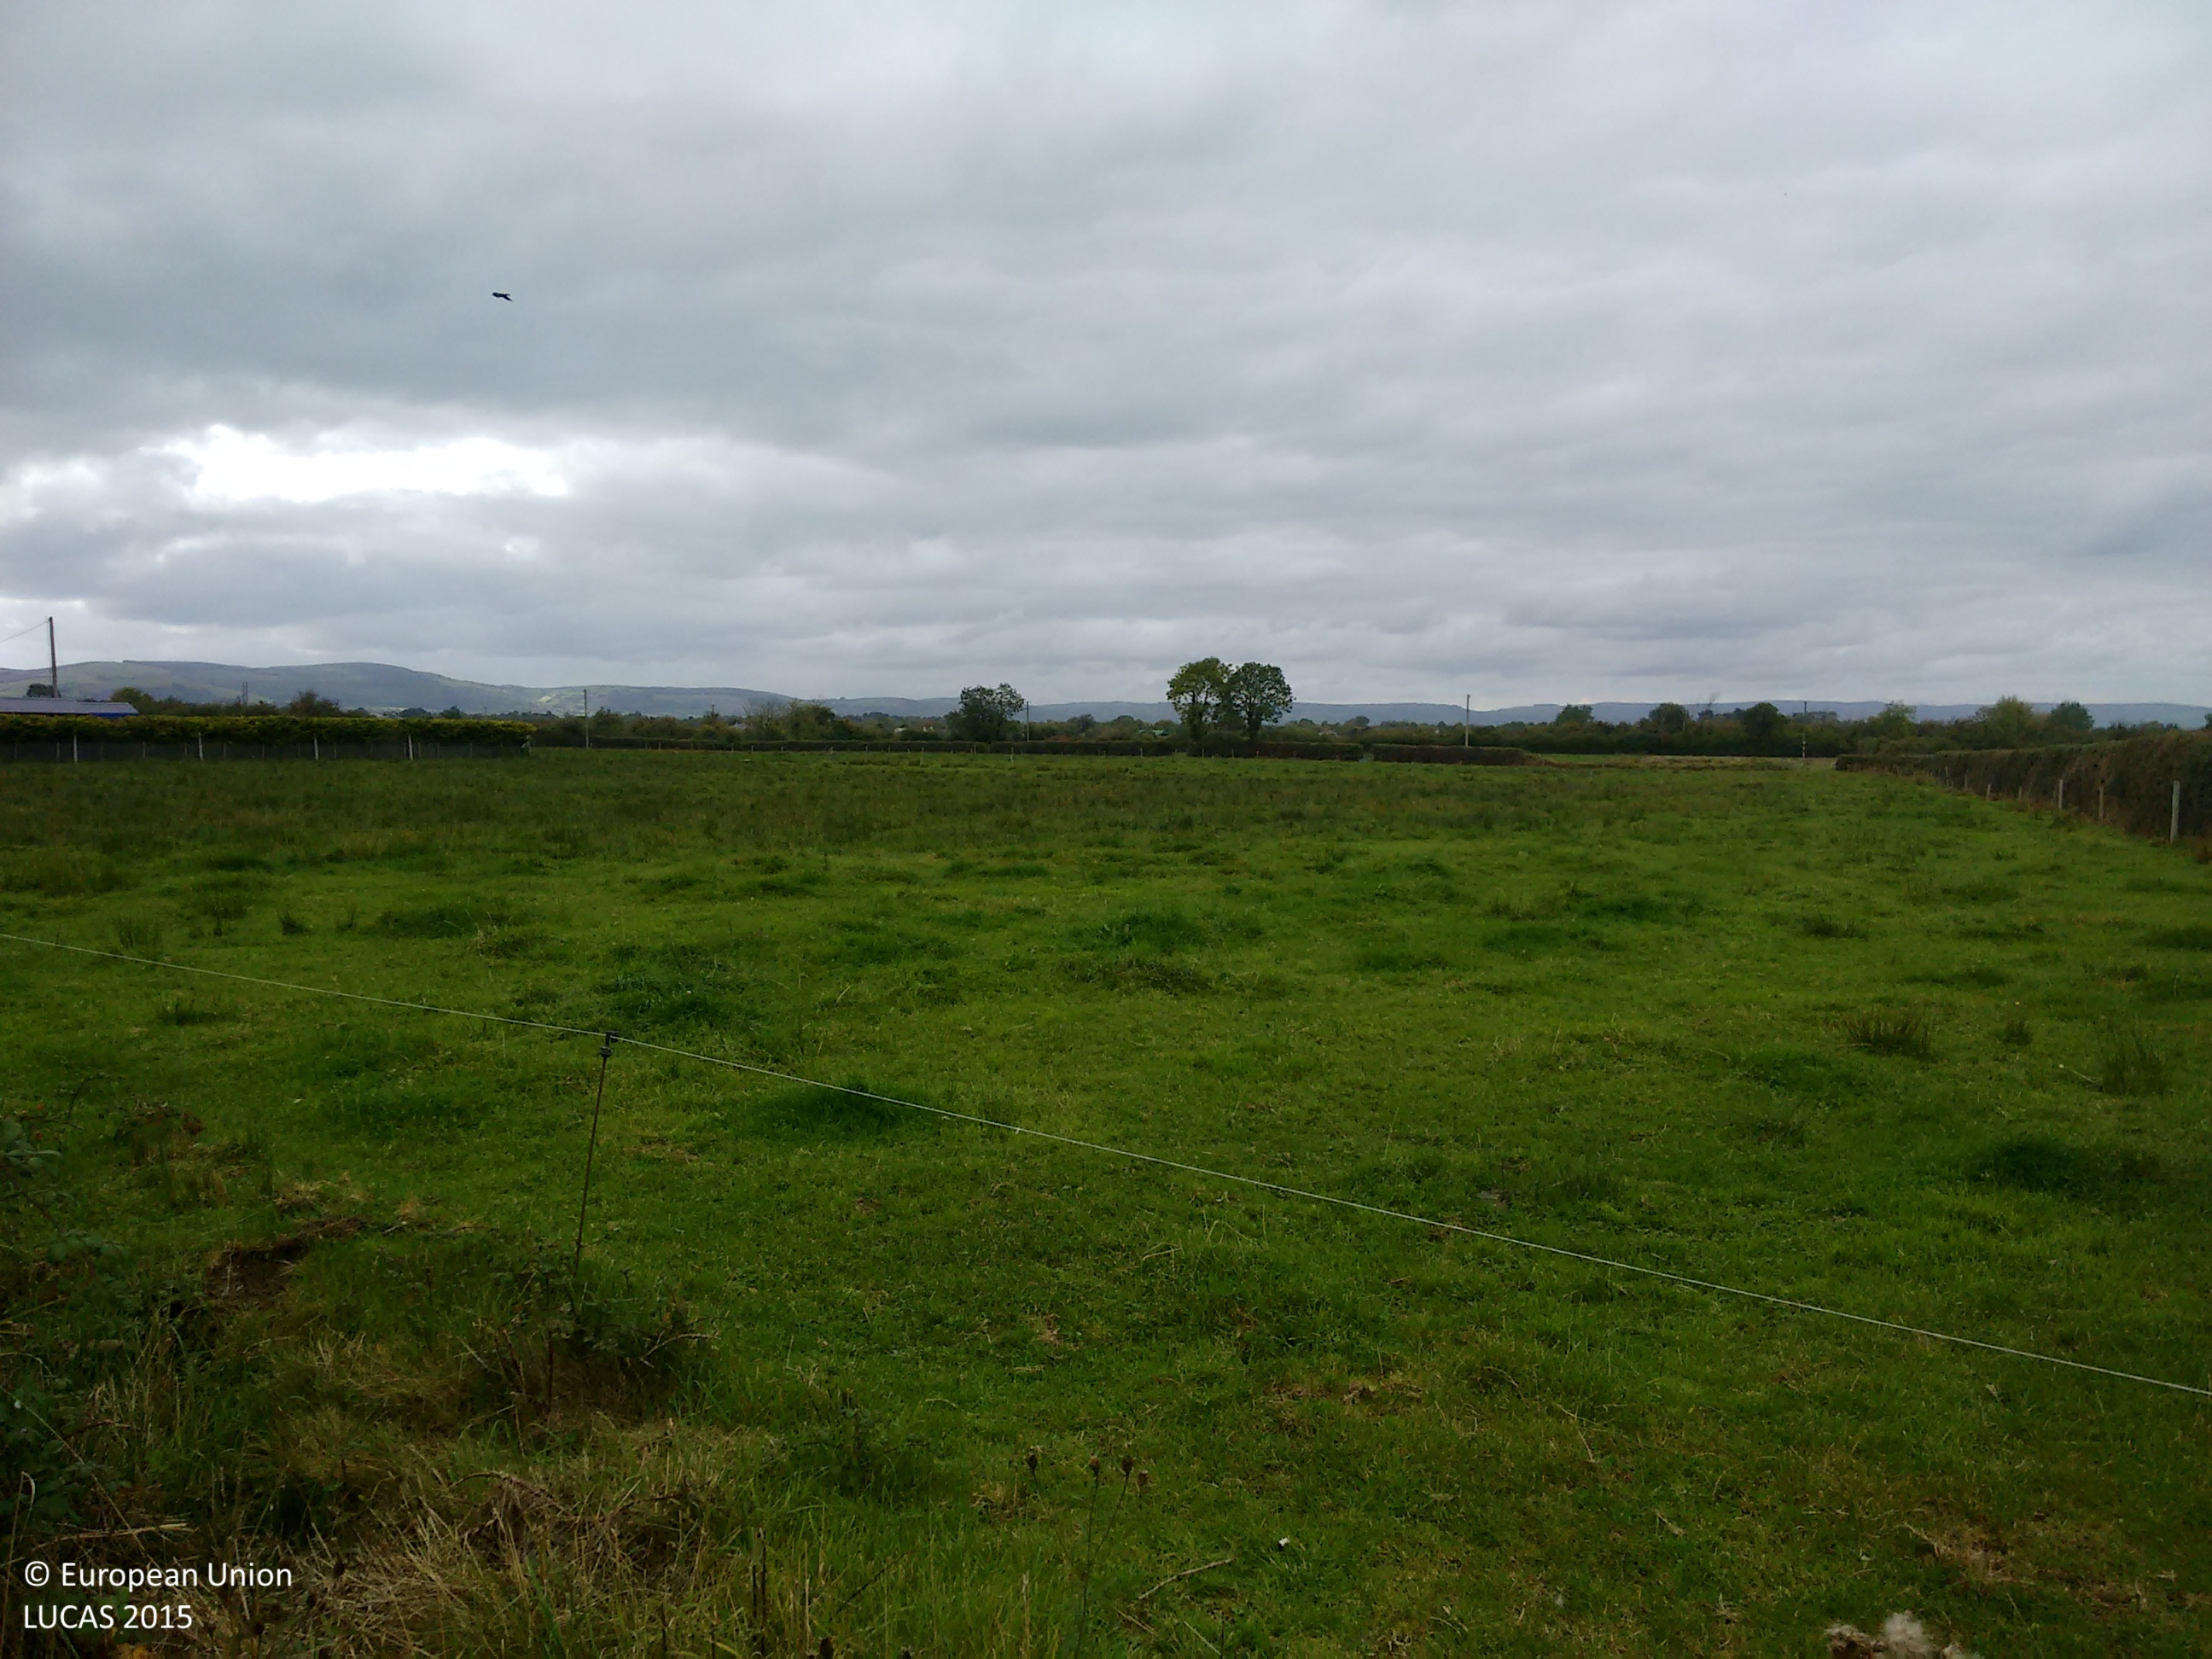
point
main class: Grassland
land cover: Grassland without tree/shrub cover
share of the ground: > 75 %
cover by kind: herbaceous plants 100 %
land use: Agriculture (excluding fallow land and kitchen gardens)
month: September
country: IE
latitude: 52.3678
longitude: -8.9361
